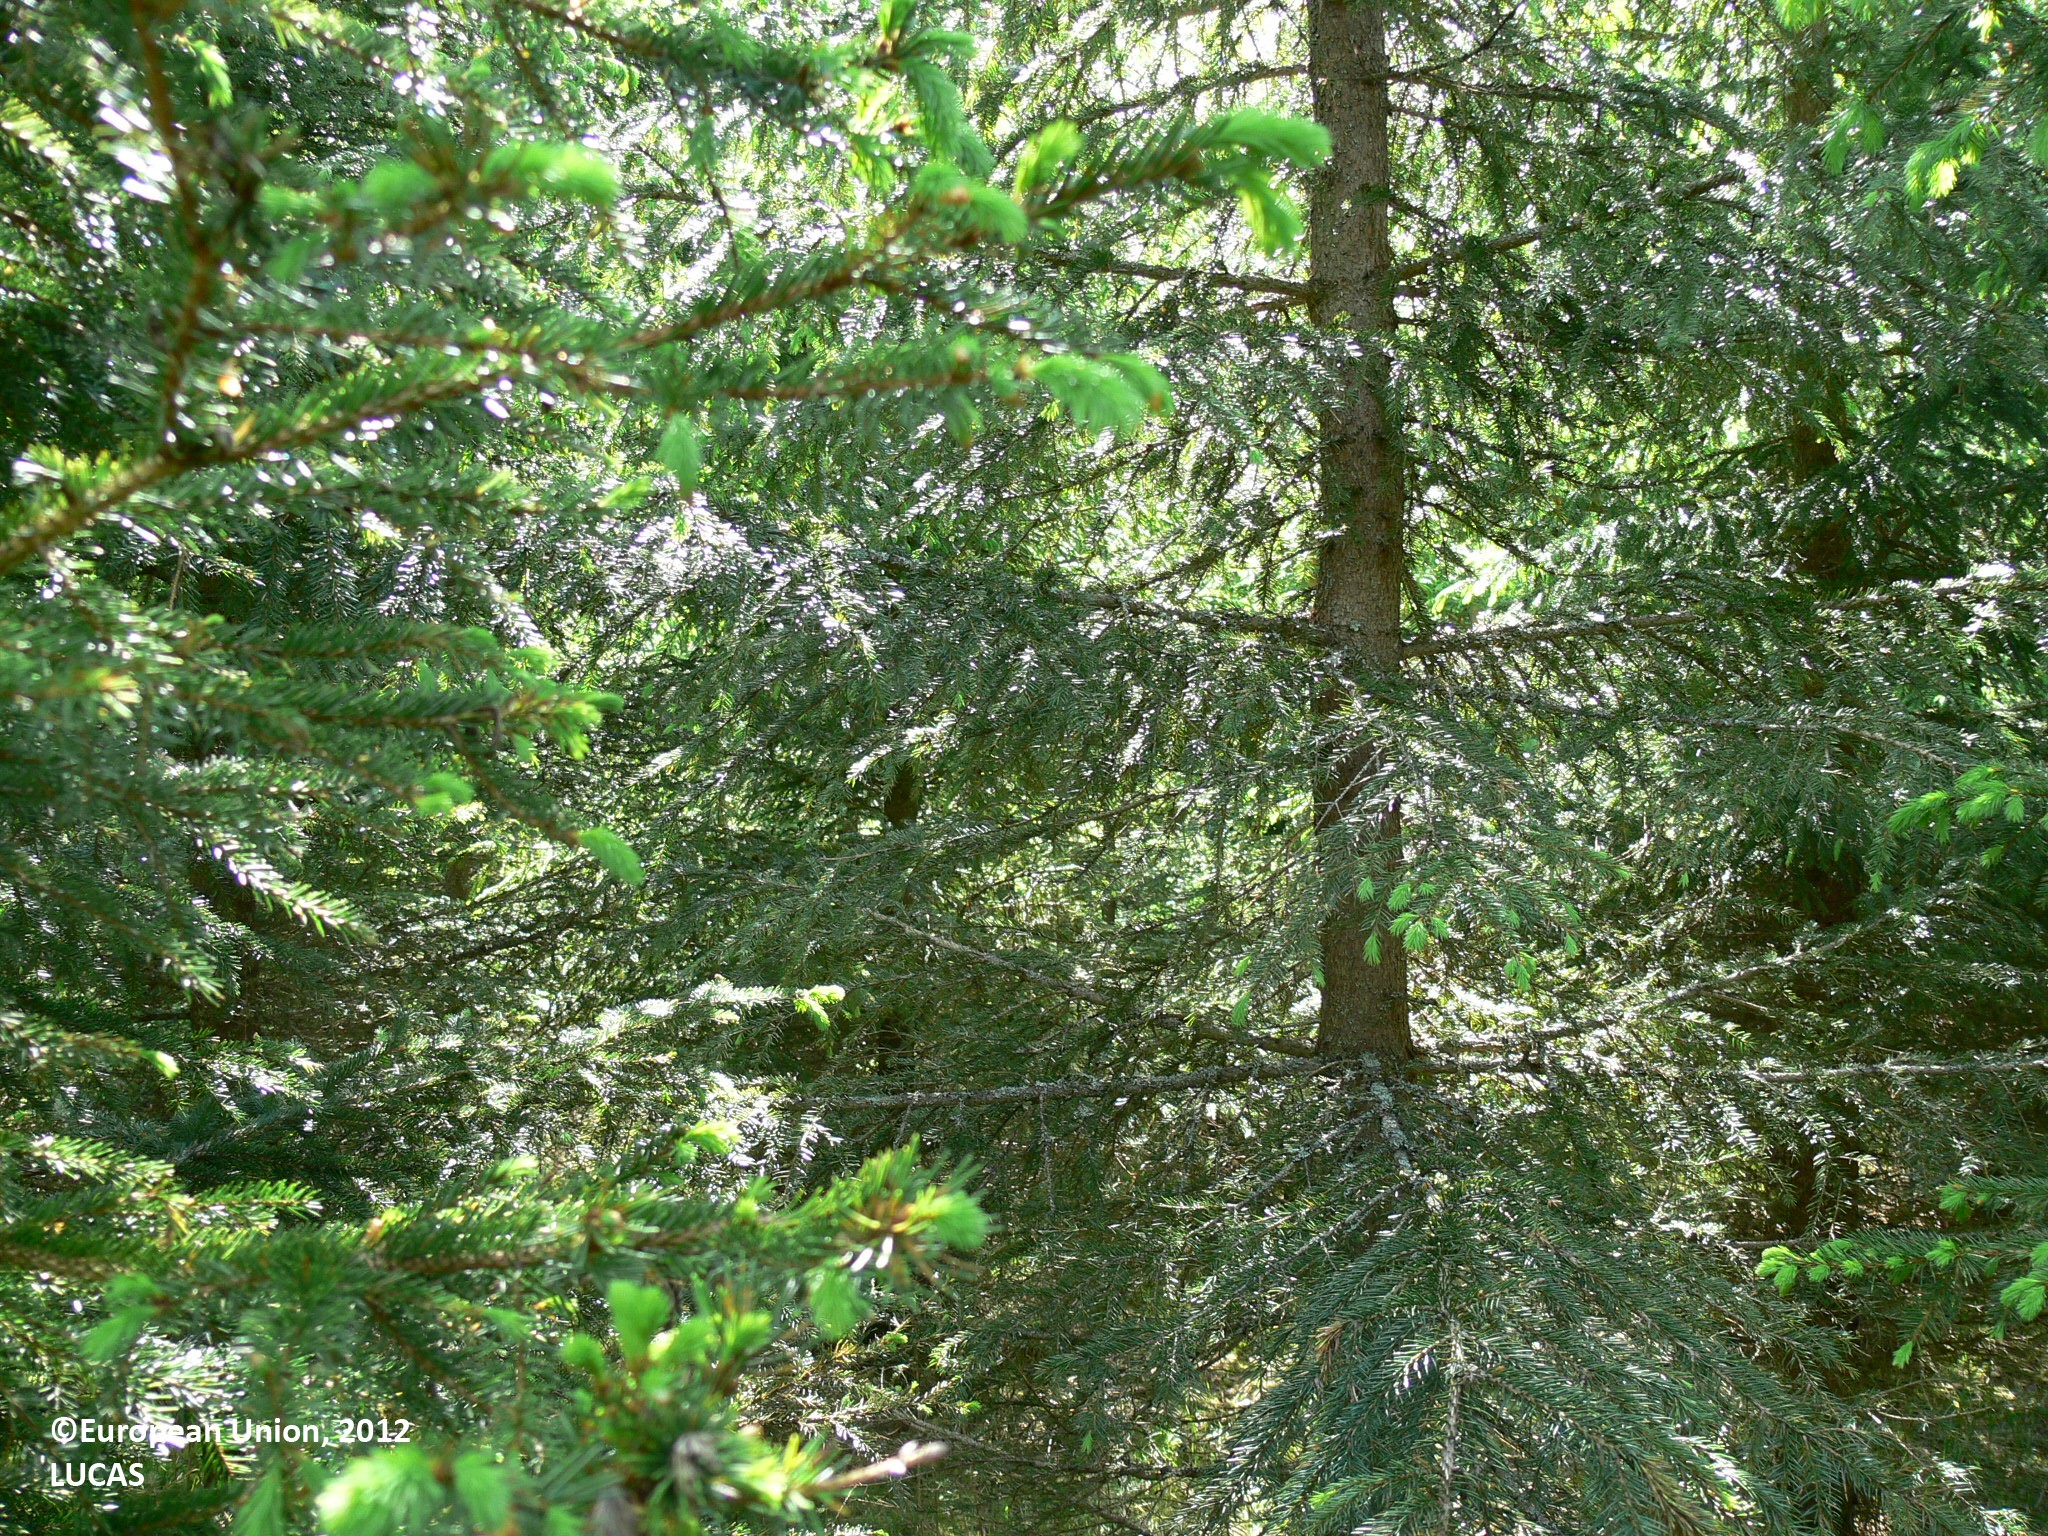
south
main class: Woodland
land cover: Spruce dominated coniferous woodland
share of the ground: > 75 %
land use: Forestry
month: June
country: FI
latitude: 62.3432
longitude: 30.4631
